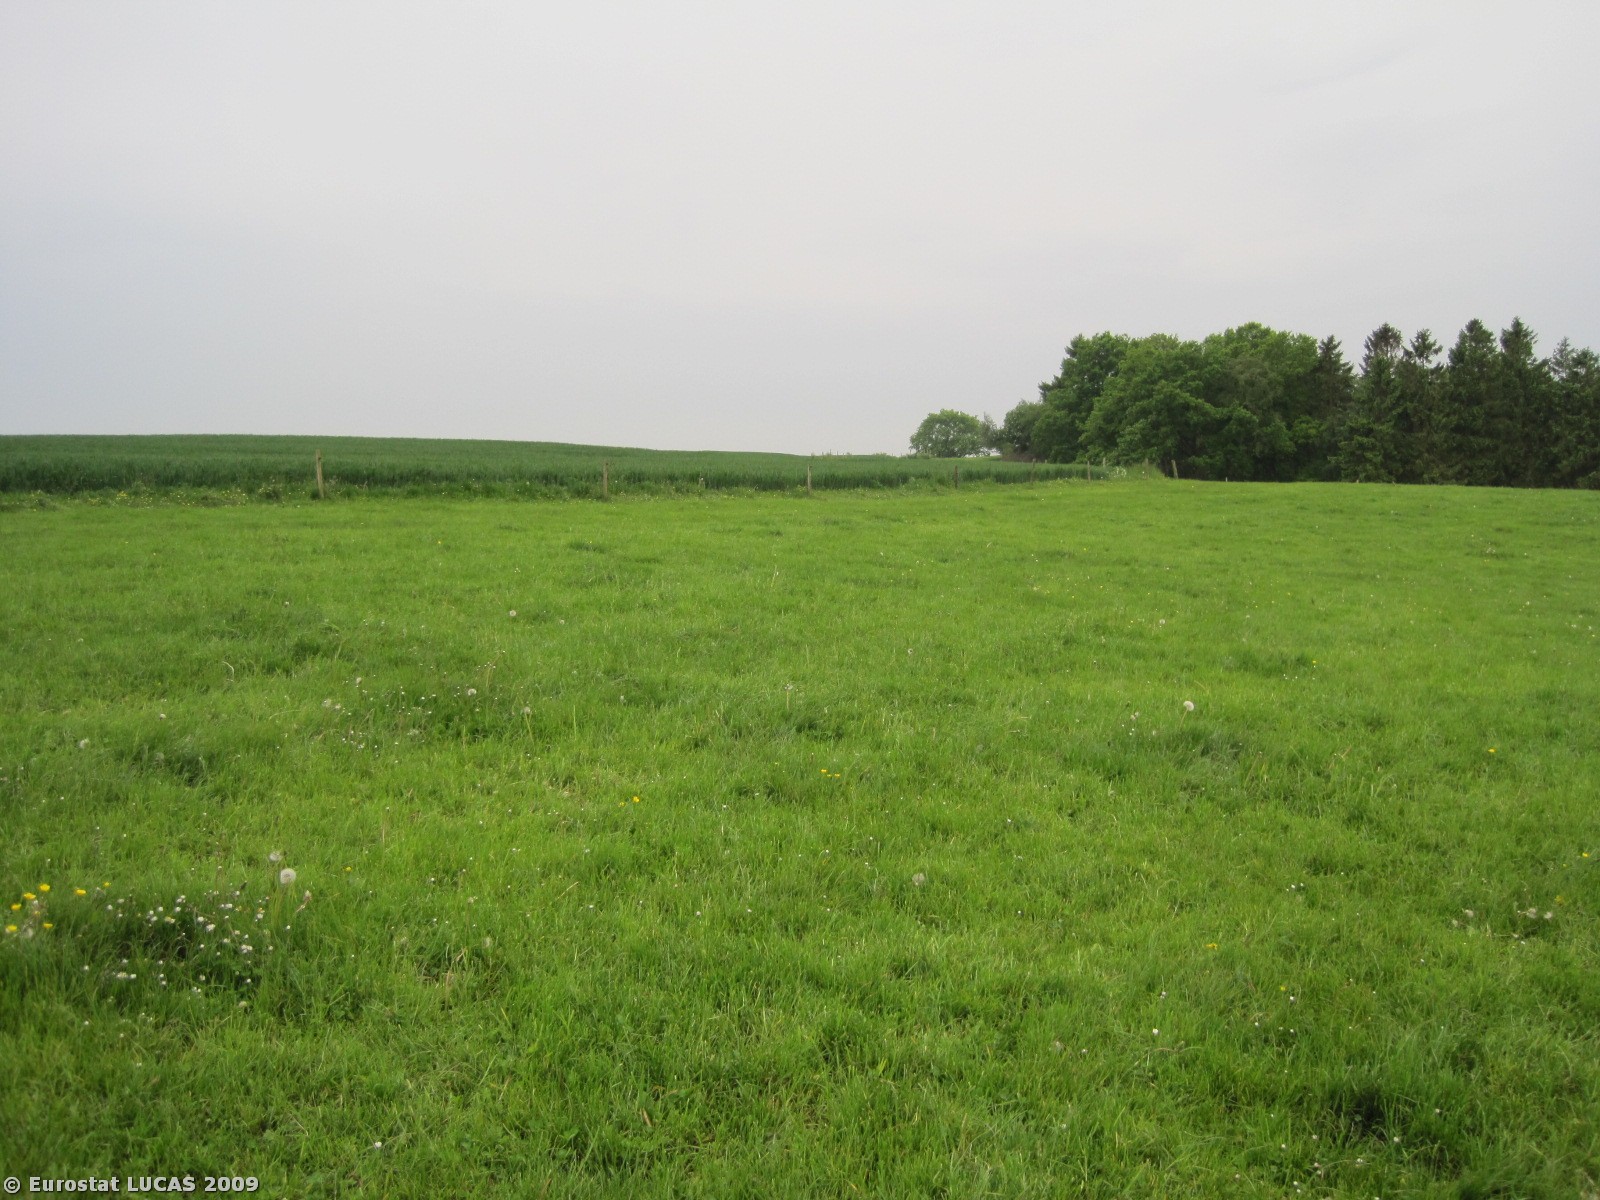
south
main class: Grassland
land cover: Grassland without tree/shrub cover
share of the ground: > 75 %
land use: Agriculture (excluding fallow land and kitchen gardens)
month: May
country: DK
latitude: 56.3136
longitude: 10.0161
